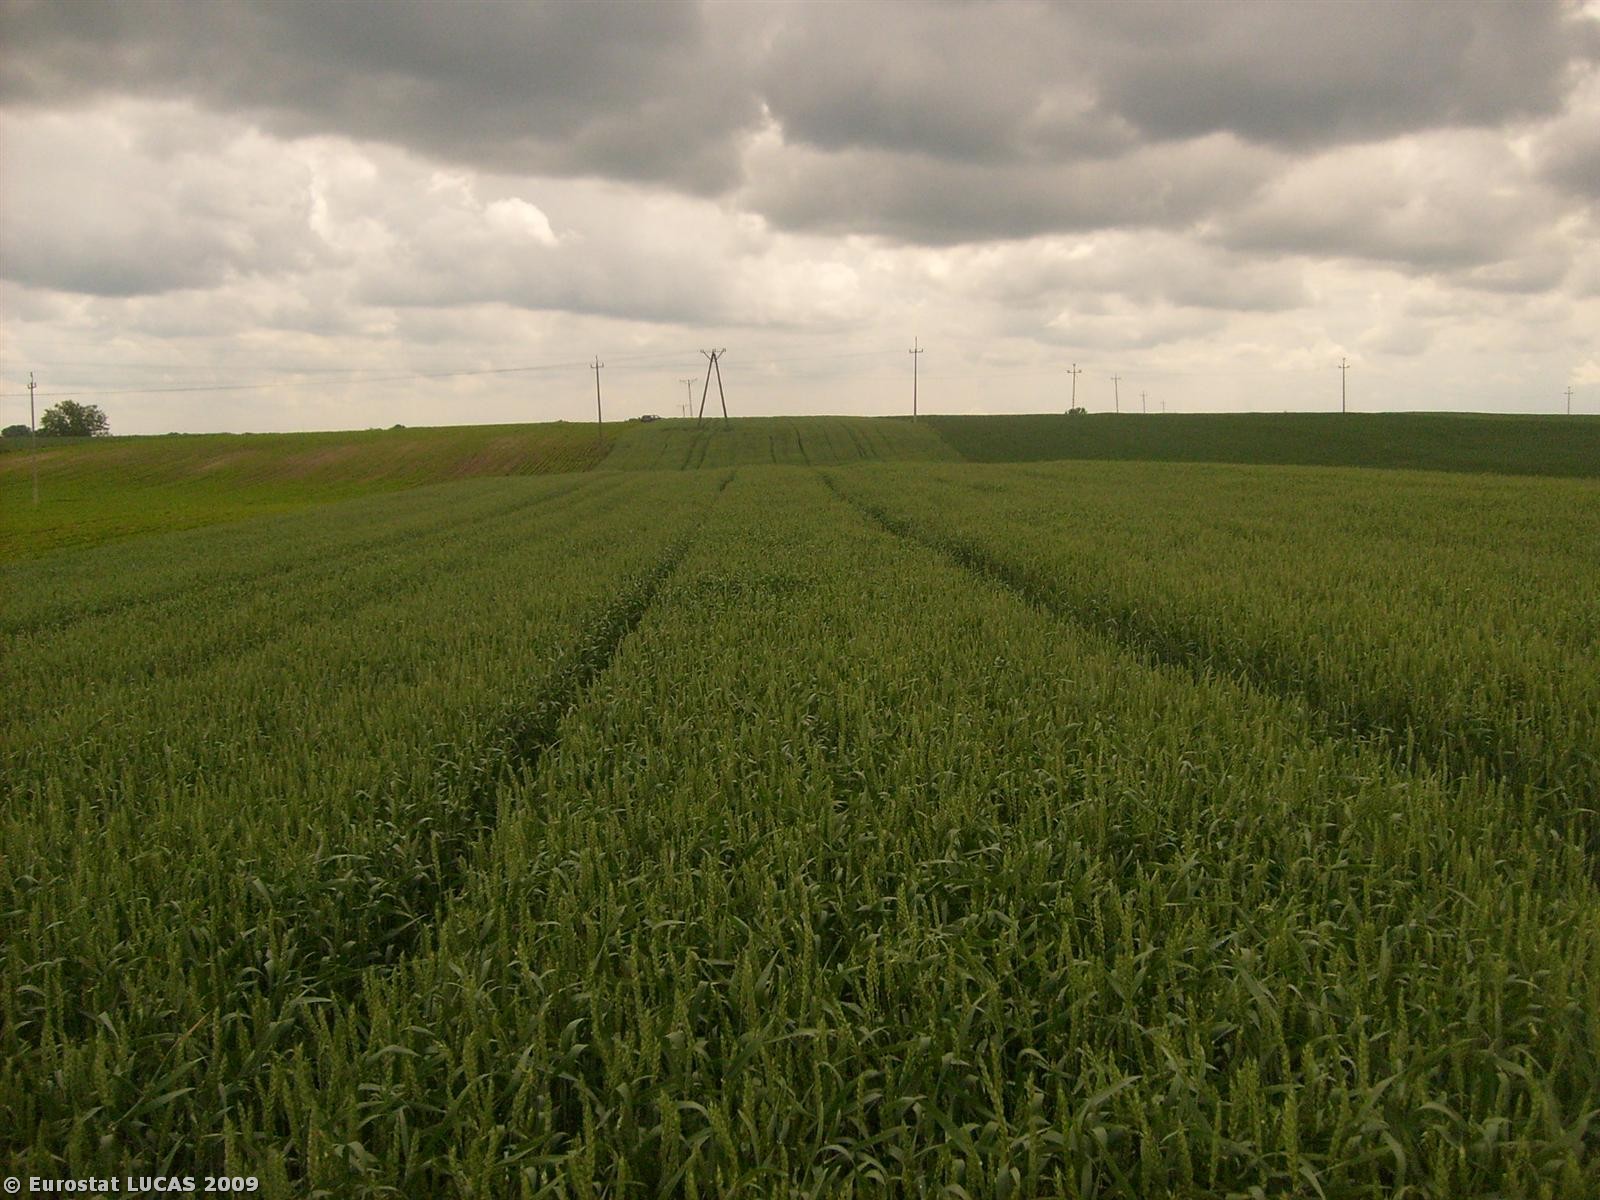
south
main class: Cropland
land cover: Common wheat
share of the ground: > 75 %
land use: Agriculture (excluding fallow land and kitchen gardens)
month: June
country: PL
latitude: 50.8270
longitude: 23.8767
